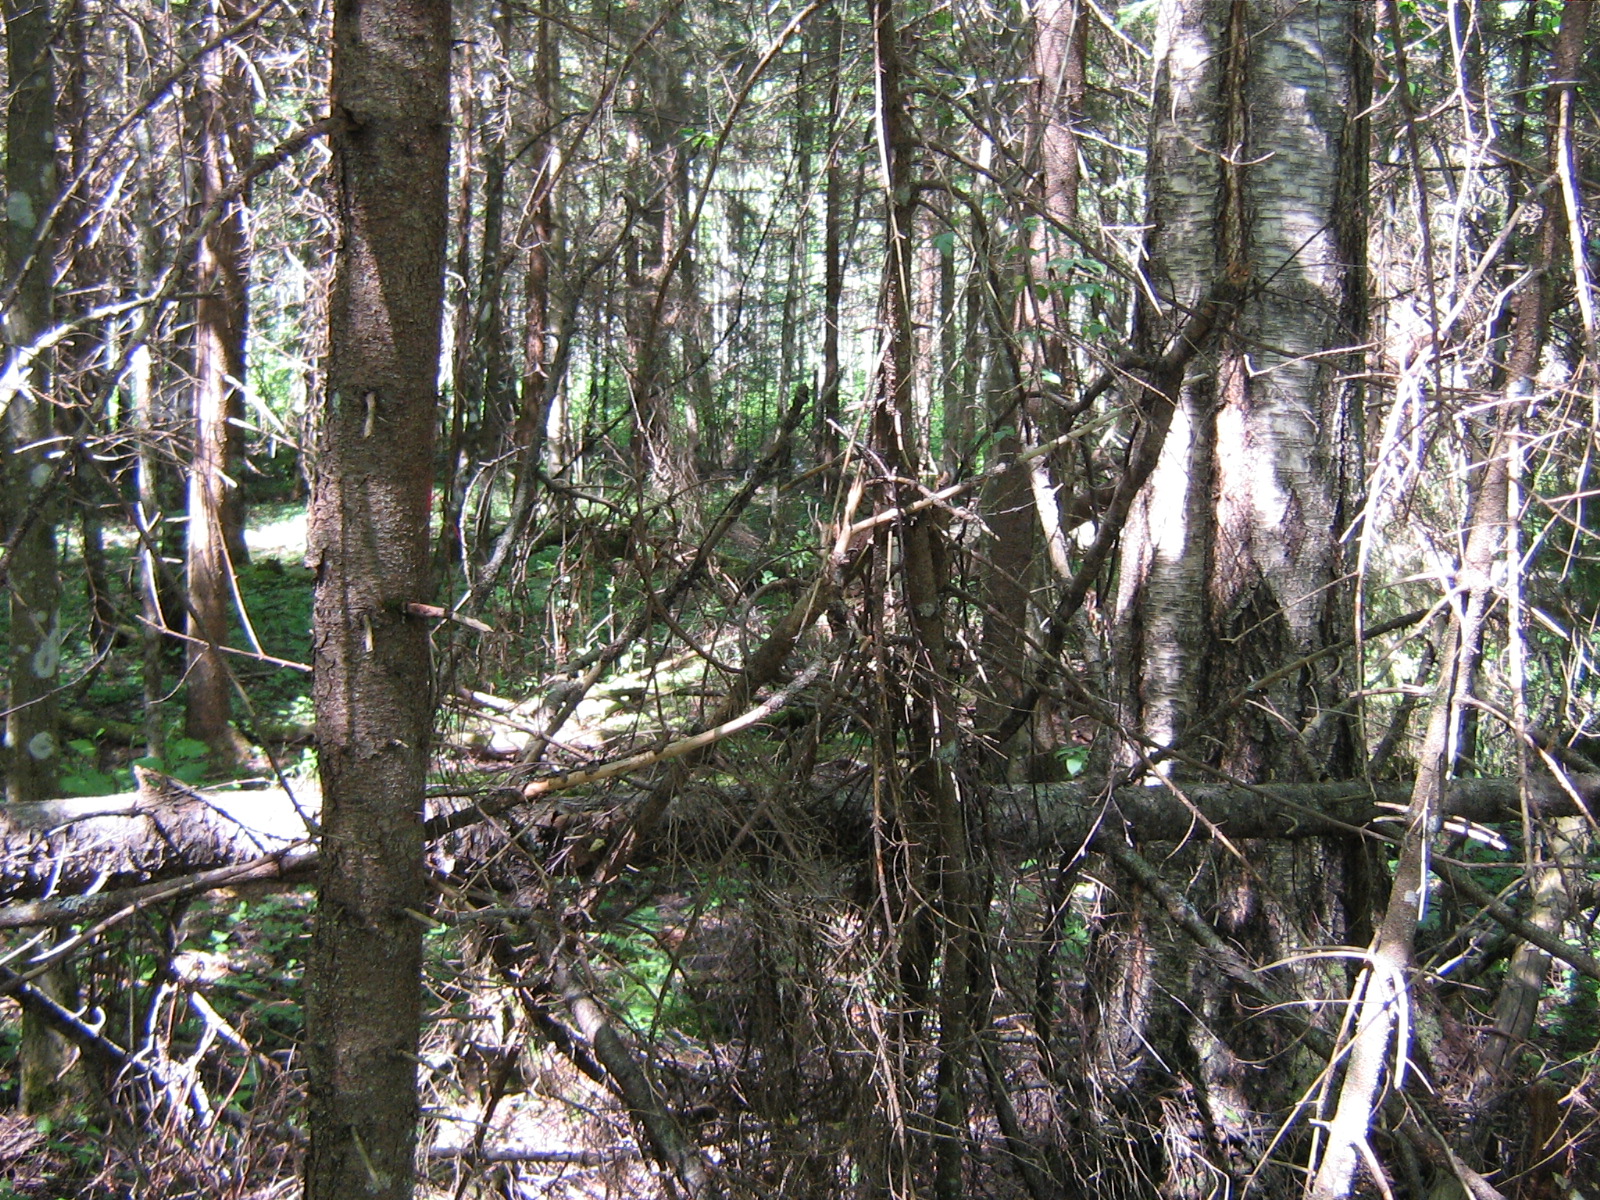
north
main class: Woodland
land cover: Spruce dominated mixed woodland
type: hemiboreal forest and nemoral coniferous forest and mixed broadleaved-coniferous forest
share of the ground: > 75 %
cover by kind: coniferous forest trees 70 %, broadleaved forest trees 30 %
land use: Forestry
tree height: > 5 m
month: June
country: LV
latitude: 56.9012
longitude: 25.4020
